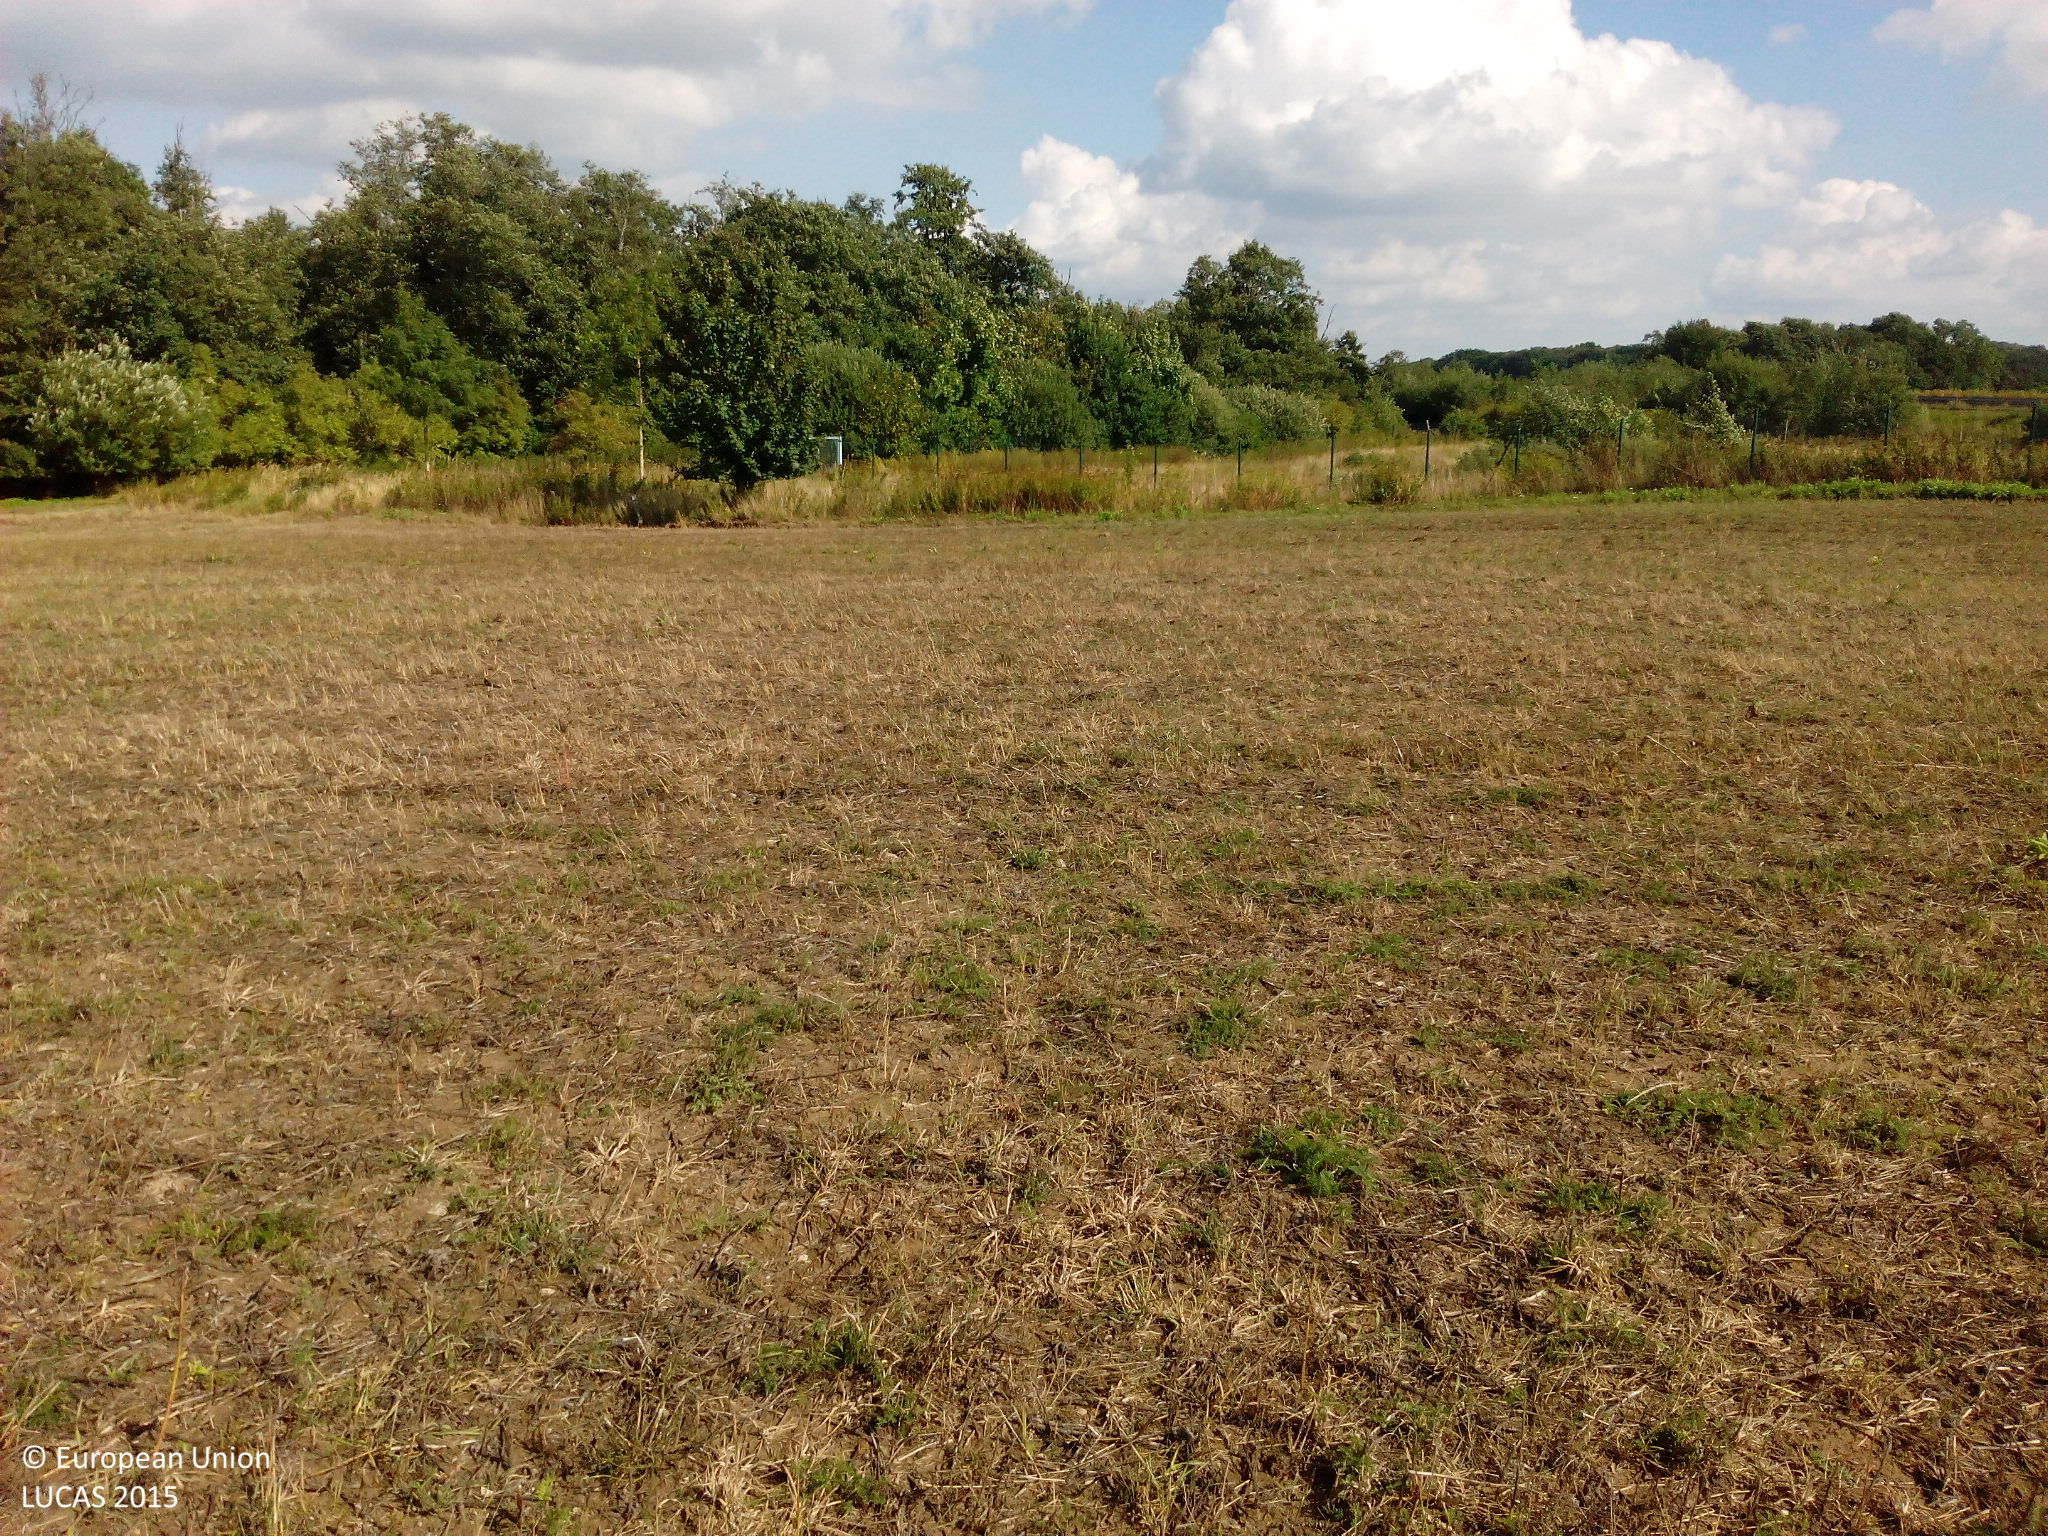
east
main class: Grassland
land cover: Spontaneously vegetated surfaces
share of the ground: 10 - 25 %
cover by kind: unconsolidated bare surface 60 %, herbaceous plants 40 %
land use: Agriculture (excluding fallow land and kitchen gardens)
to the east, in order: Spontaneously vegetated surfaces; Shruby margins; Fences; Spontaneously vegetated surfaces; Fences; Broadleaved woodland; Fences; Spontaneously vegetated surfaces; Broadleaved woodland; Inland fresh running water; Spontaneously vegetated surfaces; Broadleaved woodland; Spontaneously vegetated surfaces; Rape and turnip rape
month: August
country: DE
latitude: 54.0565
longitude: 12.6419
